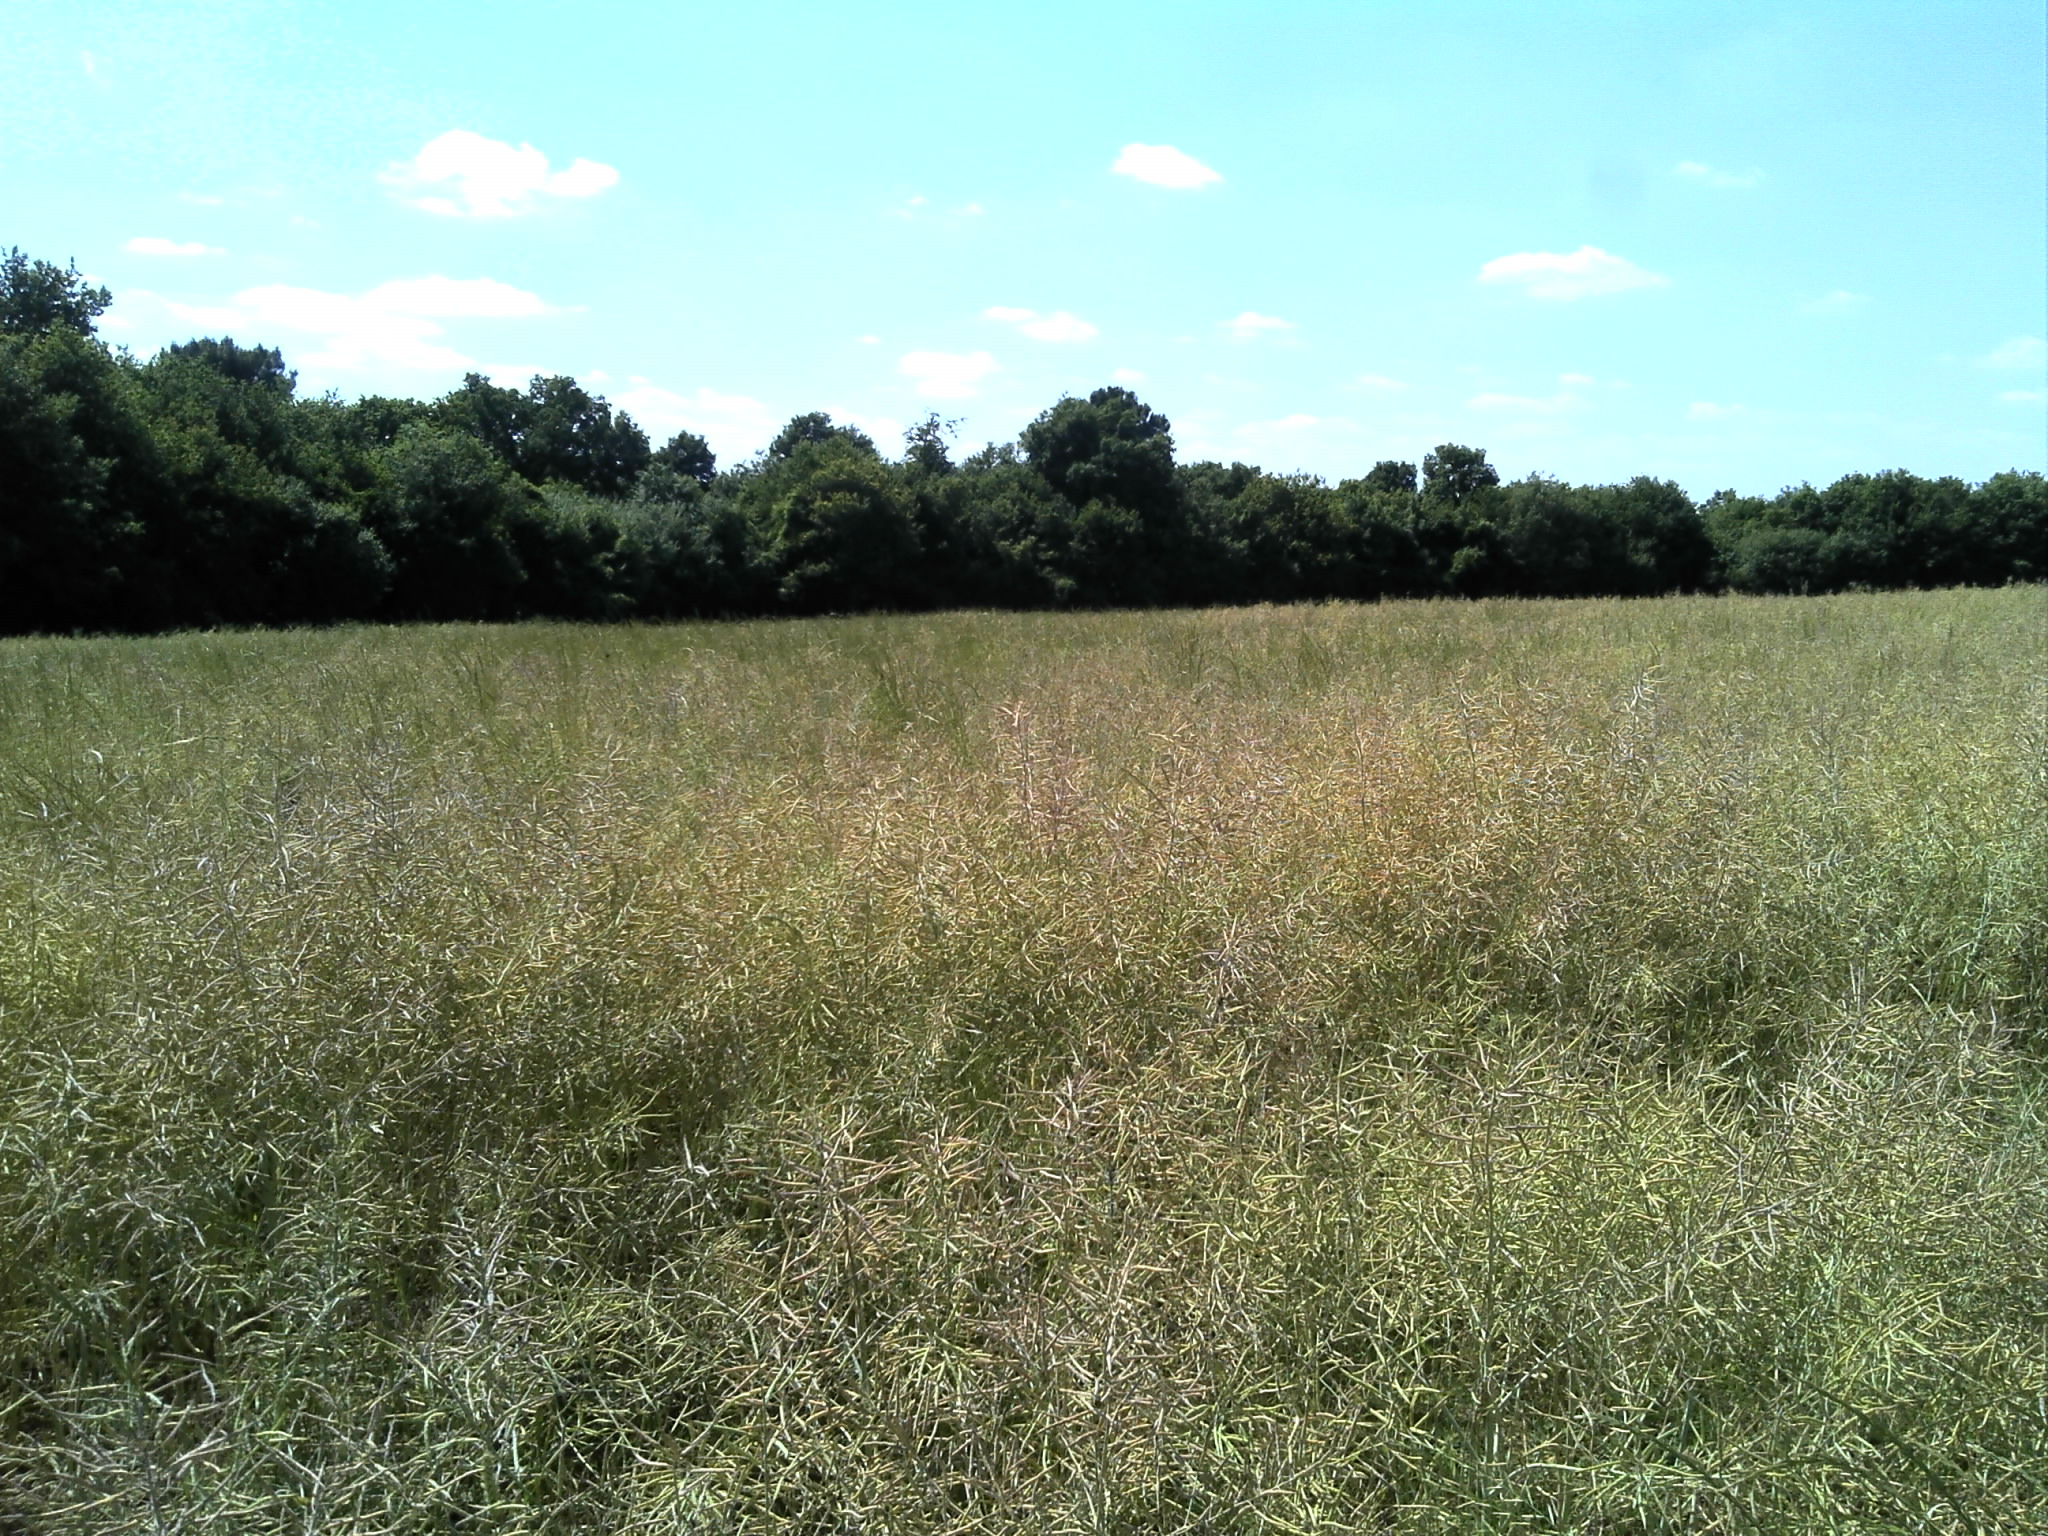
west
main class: Cropland
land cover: Rape and turnip rape
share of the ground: > 75 %
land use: Agriculture (excluding fallow land and kitchen gardens)
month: June
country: FR
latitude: 47.1493
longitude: 1.4545
